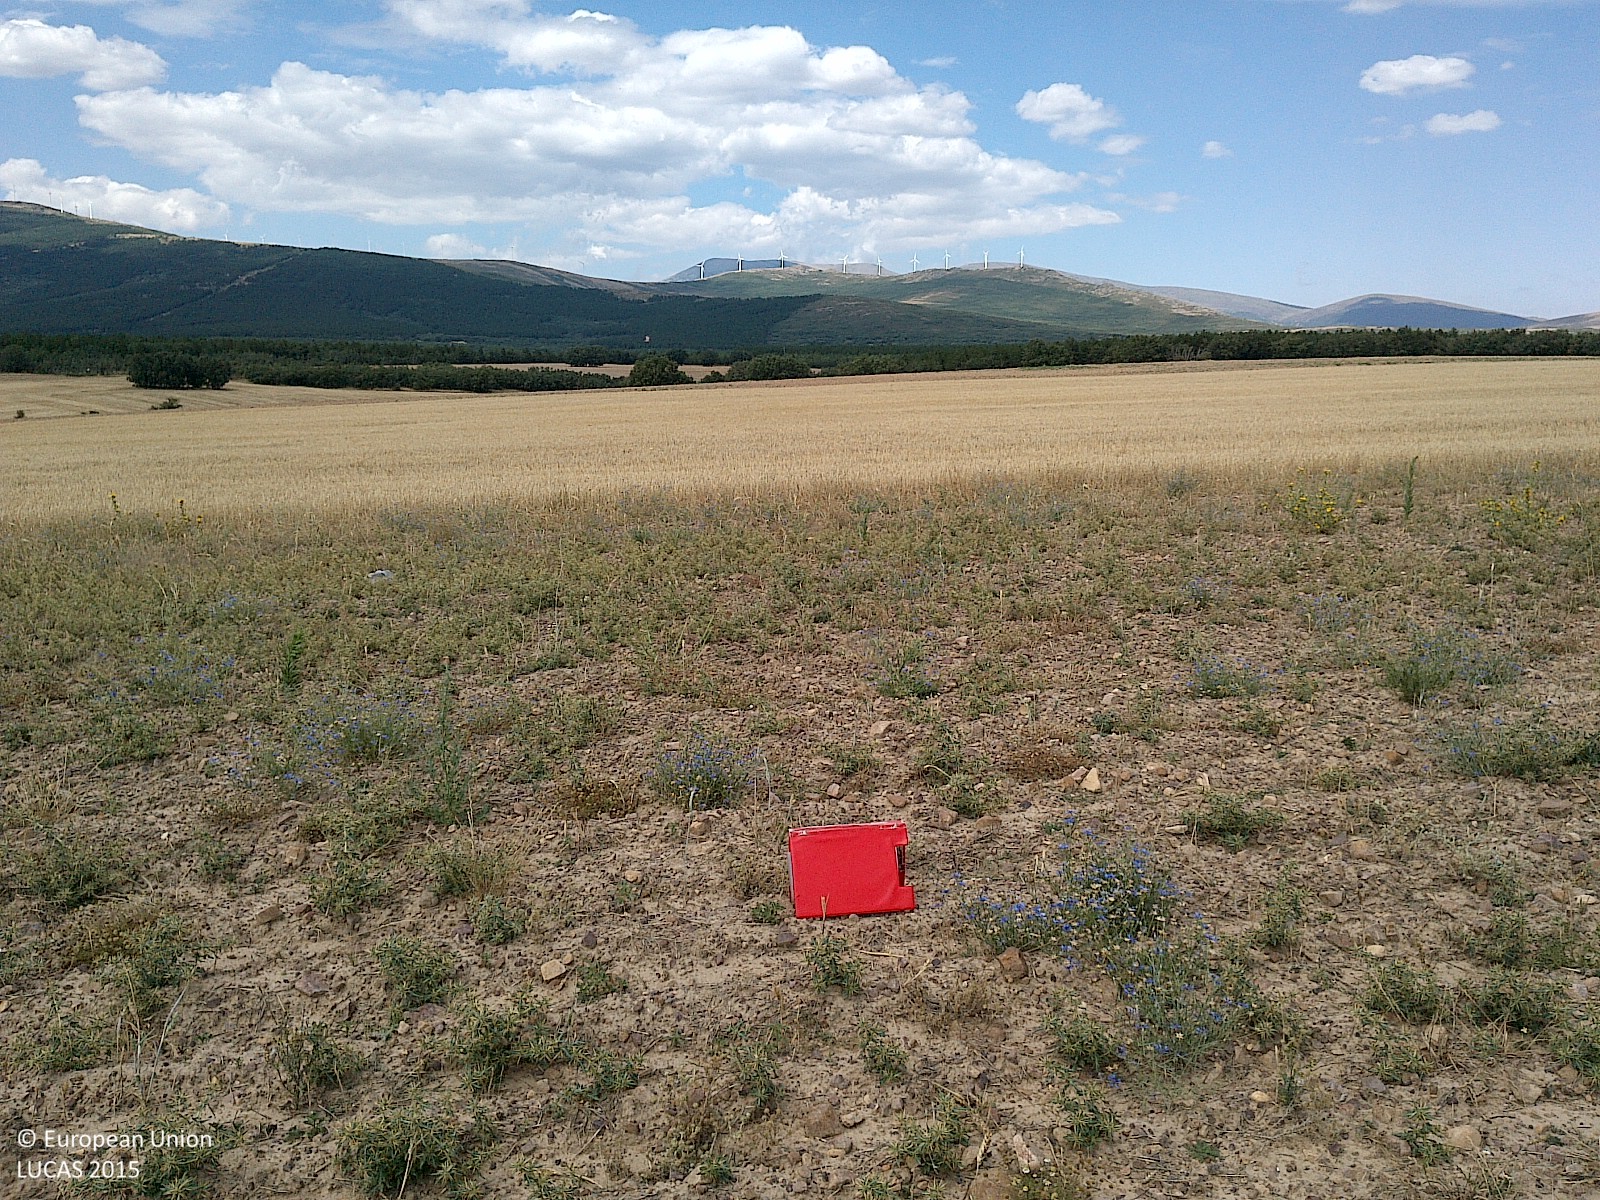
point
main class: Grassland
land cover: Spontaneously vegetated surfaces
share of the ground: 10 - 25 %
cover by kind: unconsolidated bare surface 85 %, herbaceous plants 15 %
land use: Fallow land
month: July
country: ES
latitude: 41.6721
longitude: -1.9345
